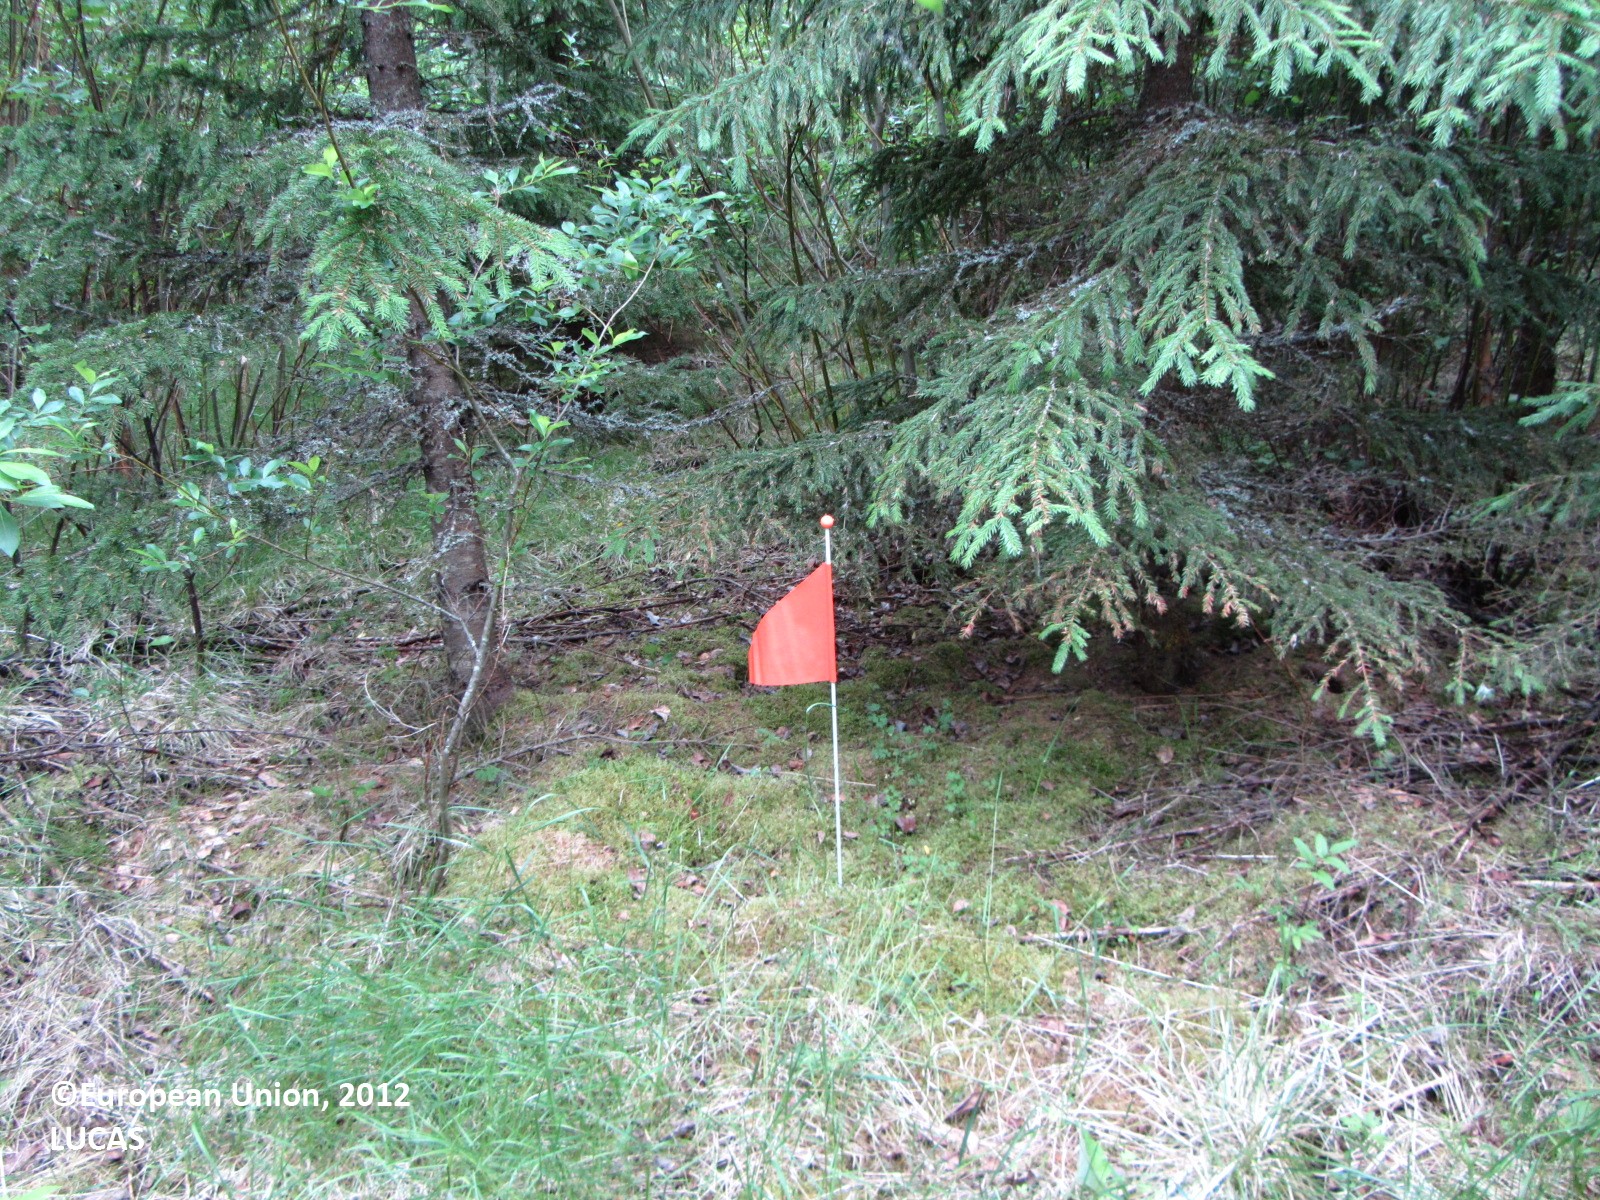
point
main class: Woodland
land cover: Spruce dominated mixed woodland
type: boreal forest
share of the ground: > 75 %
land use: Forestry
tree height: > 5 m
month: June
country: FI
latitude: 62.6211
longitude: 25.6090
